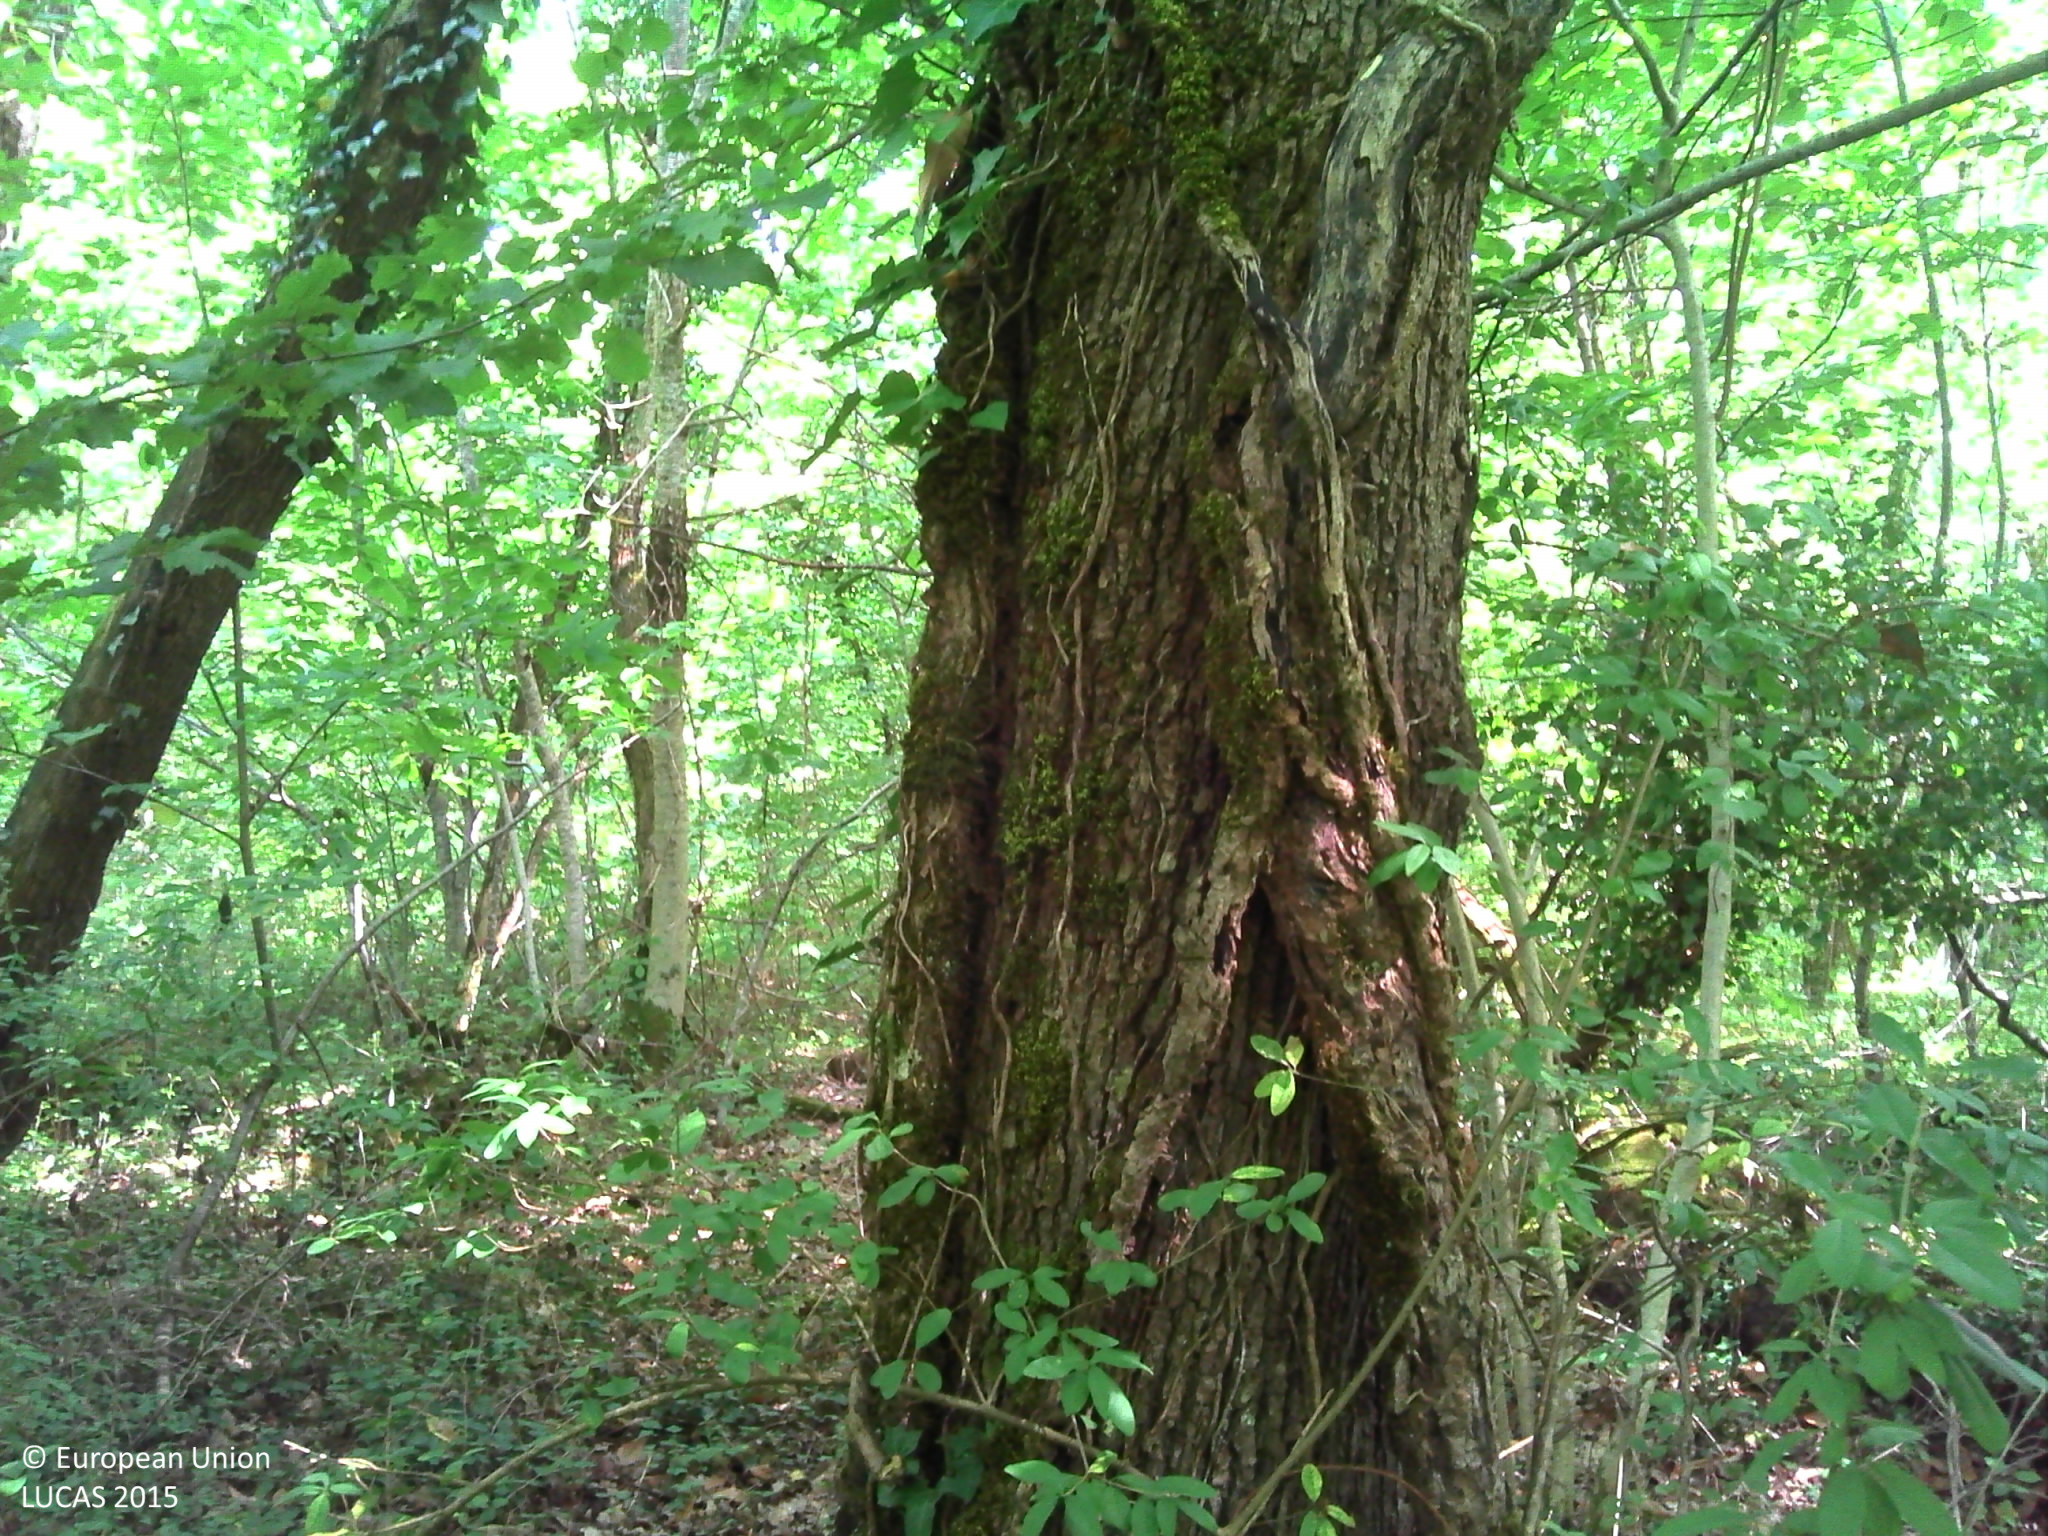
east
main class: Woodland
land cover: Broadleaved woodland
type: thermophilous deciduous forest
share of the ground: > 75 %
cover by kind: broadleaved forest trees 70 %, shrubs 20 %, herbaceous plants 5 %, lichens and mosses 5 %
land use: Forestry
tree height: > 5 m
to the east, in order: Broadleaved woodland; Grassland without tree/shrub cover; Ponds and wetlands; Grassland without tree/shrub cover; Shrubland without tree cover; Broadleaved woodland
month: August
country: FR
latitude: 45.3632
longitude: 0.4763
